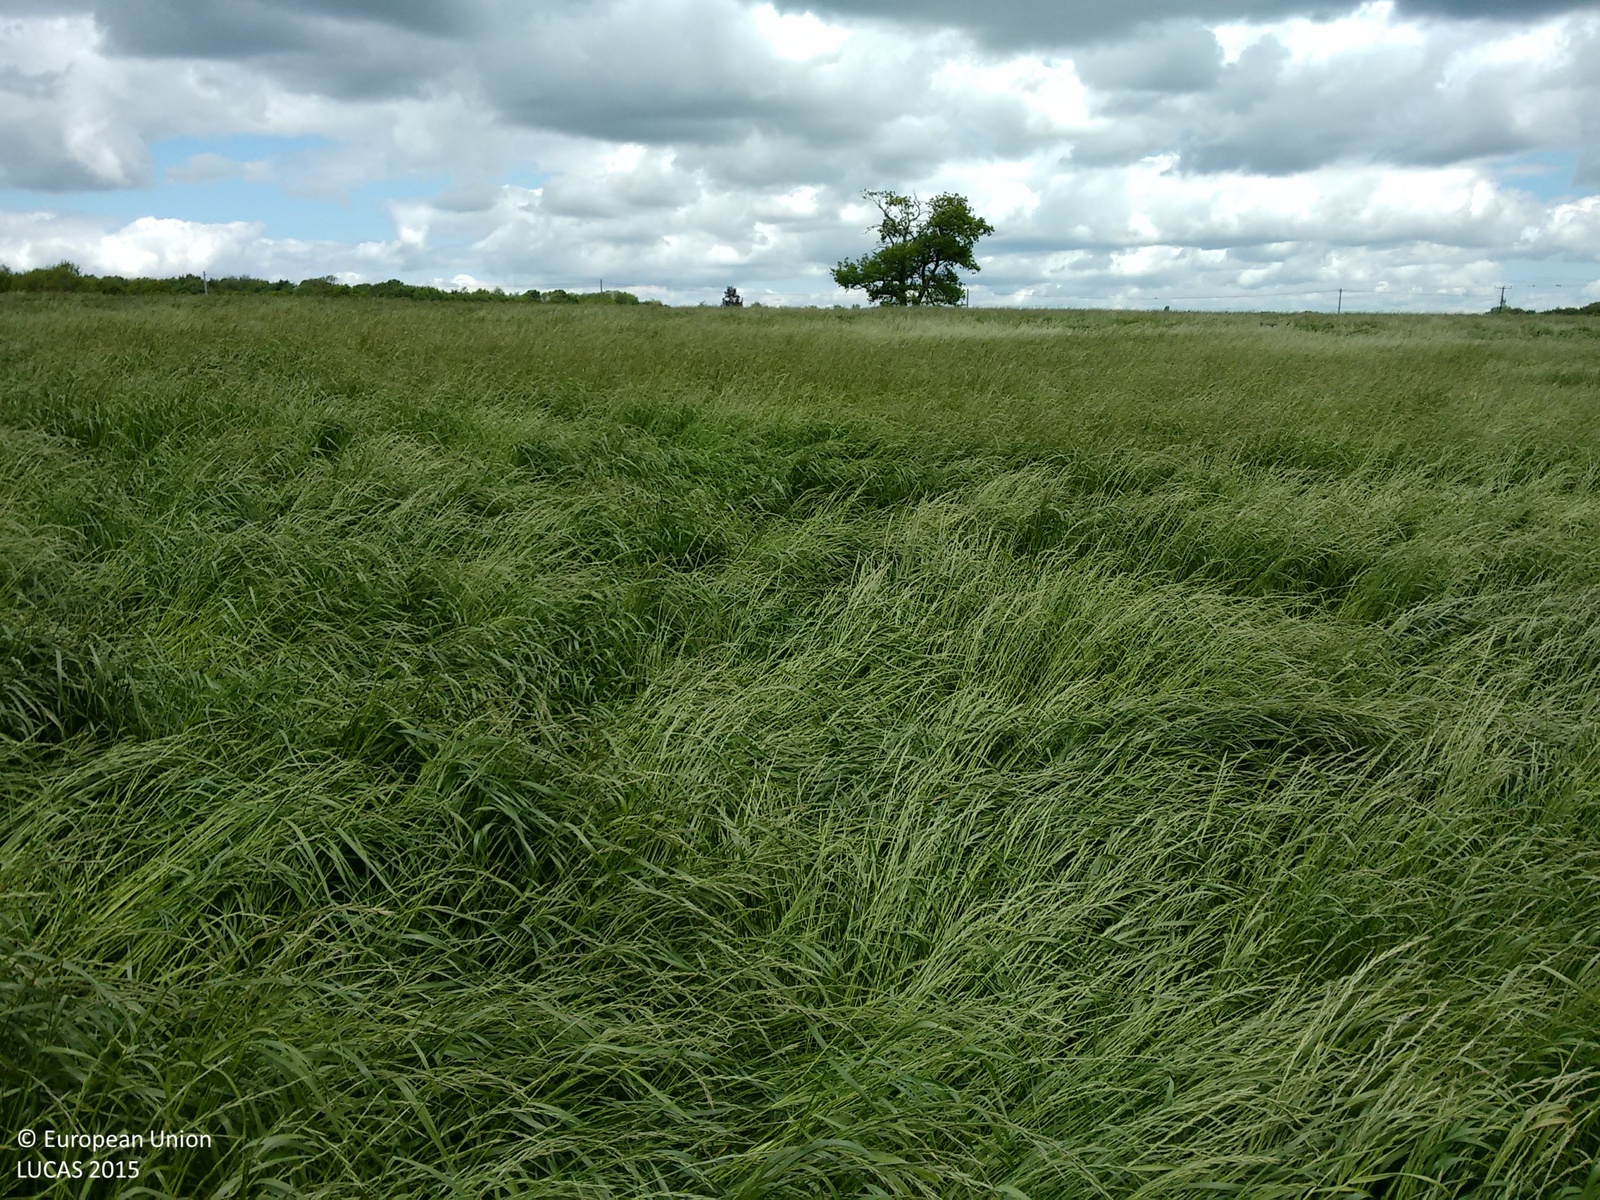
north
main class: Cropland
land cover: Temporary grasslands
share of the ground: > 75 %
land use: Agriculture (excluding fallow land and kitchen gardens)
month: May
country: GB
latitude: 51.8880
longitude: 0.0734
